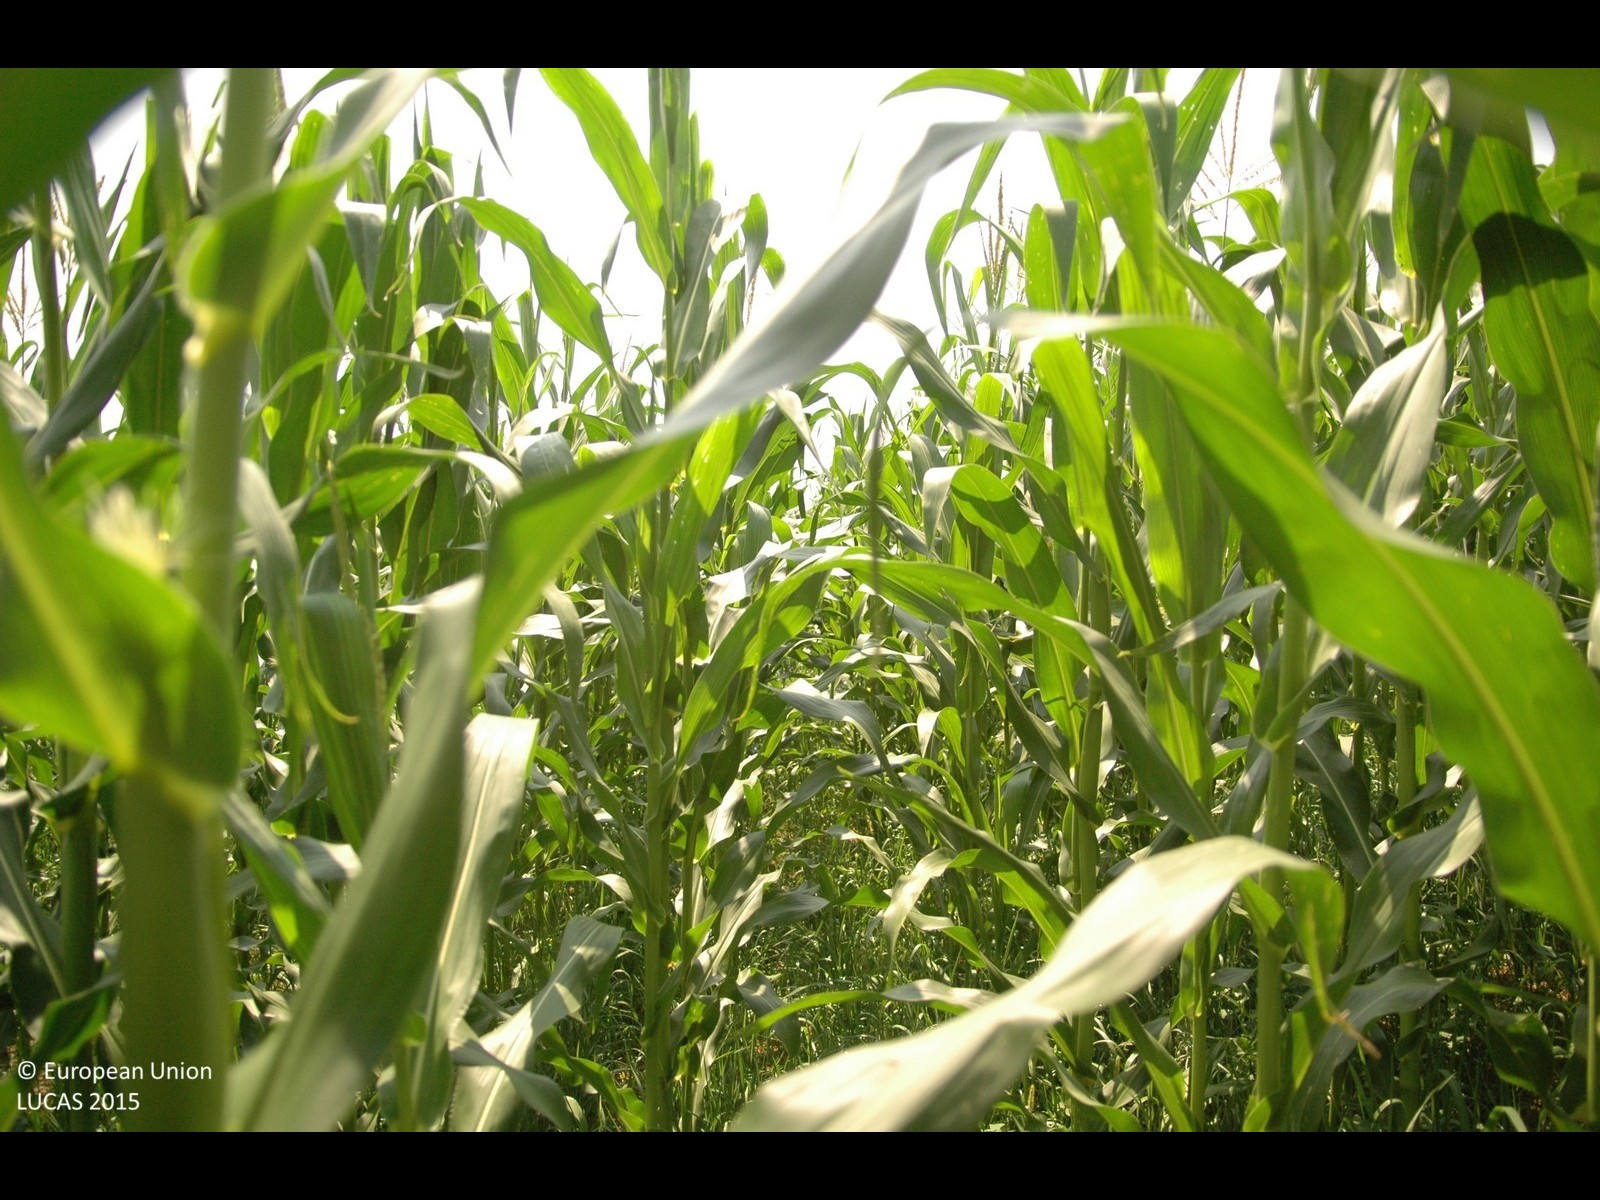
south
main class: Cropland
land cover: Maize
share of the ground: > 75 %
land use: Agriculture (excluding fallow land and kitchen gardens)
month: July
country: HR
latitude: 46.1412
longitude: 16.0963
